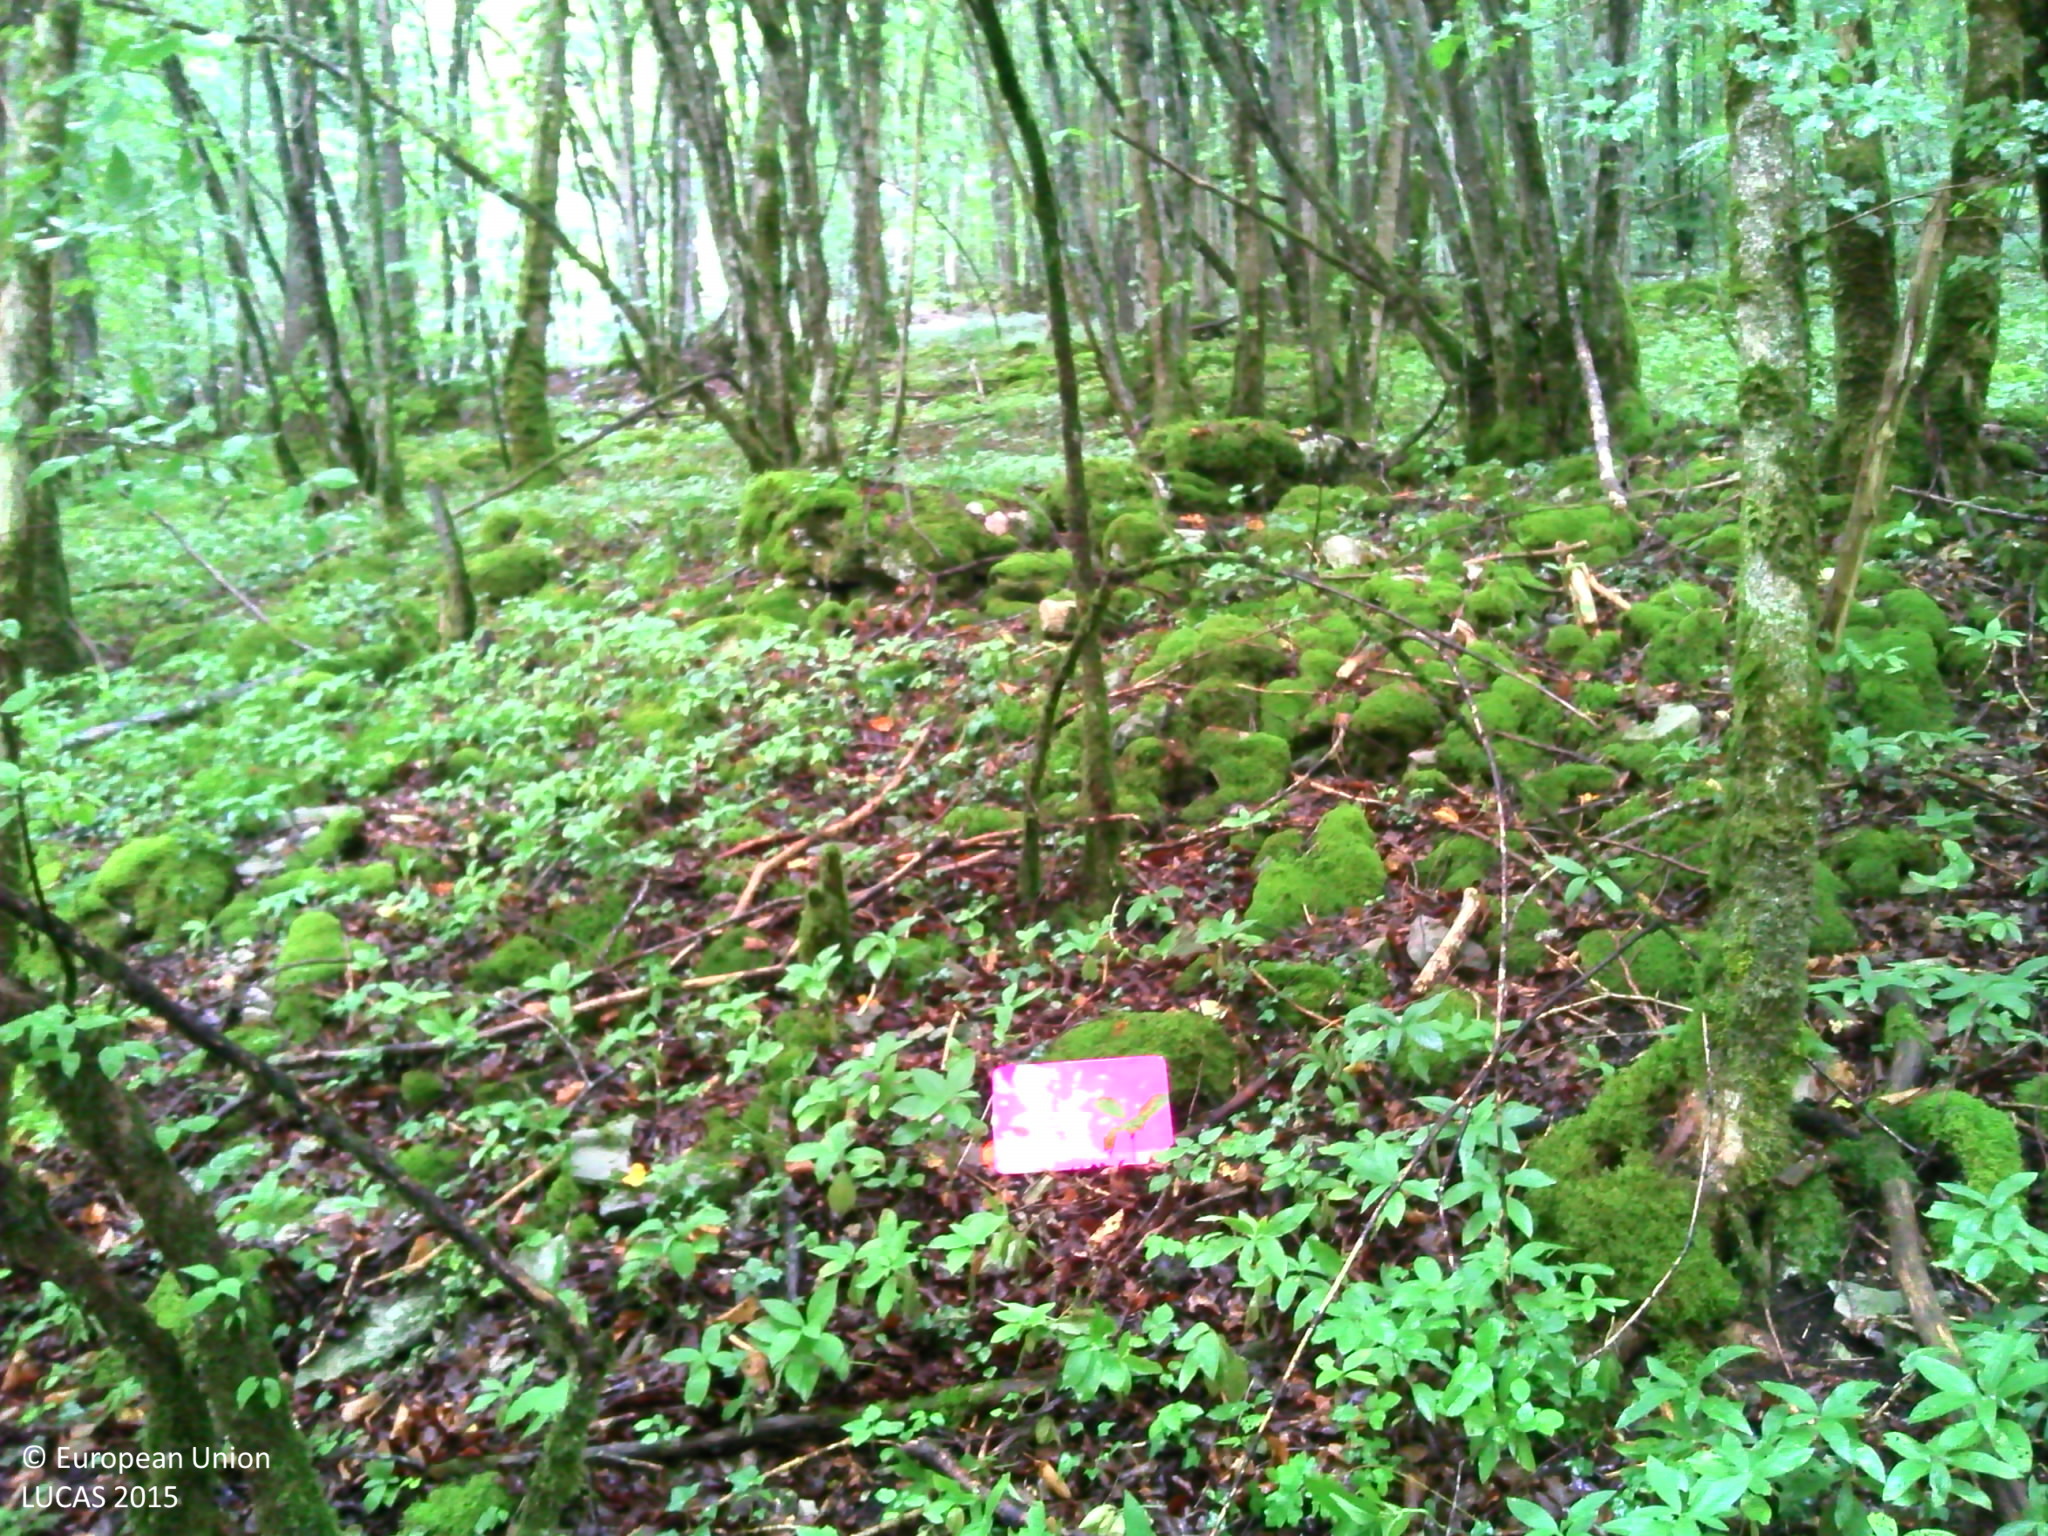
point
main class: Woodland
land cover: Broadleaved woodland
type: mesophytic deciduous forest
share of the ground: > 75 %
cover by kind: broadleaved forest trees 75 %, herbaceous plants 15 %, shrubs 10 %
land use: Forestry
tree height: > 5 m
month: September
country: FR
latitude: 47.1408
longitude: 4.7128
